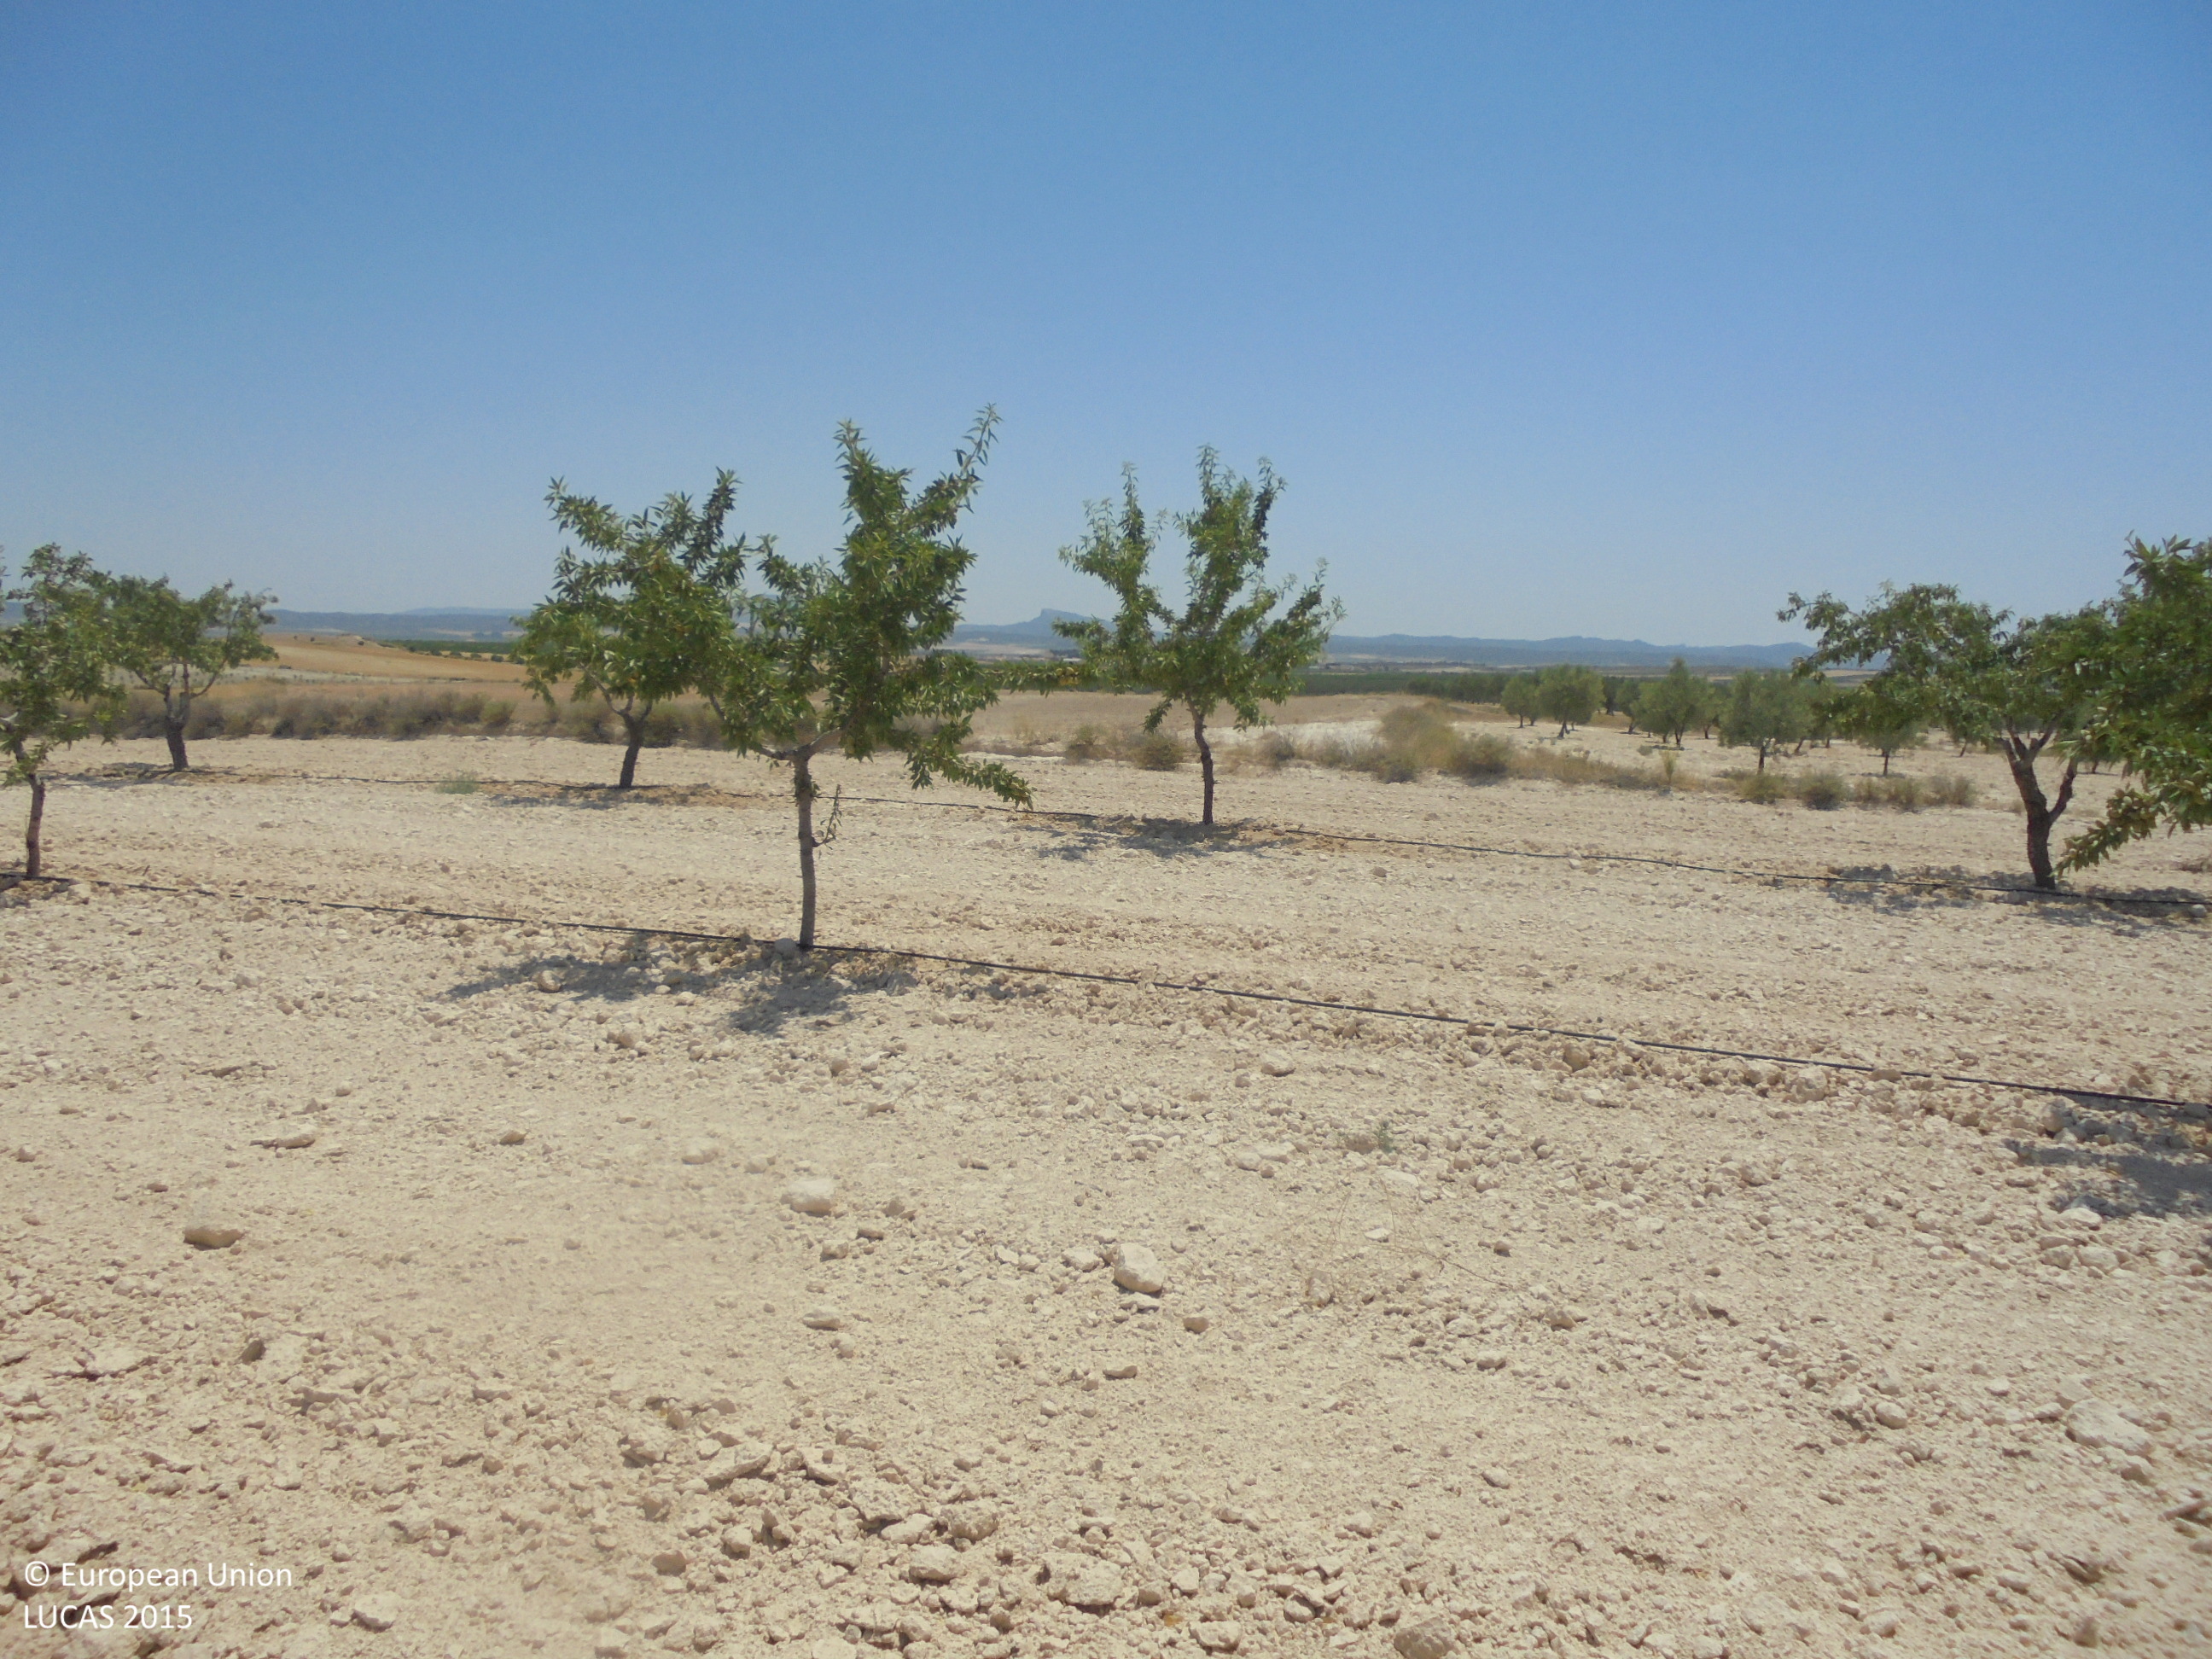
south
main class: Cropland
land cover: Nuts trees
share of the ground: 10 - 25 %
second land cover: Other bare soil
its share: > 75 %
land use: Agriculture (excluding fallow land and kitchen gardens)
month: July
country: ES
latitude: 38.5982
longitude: -1.5328
